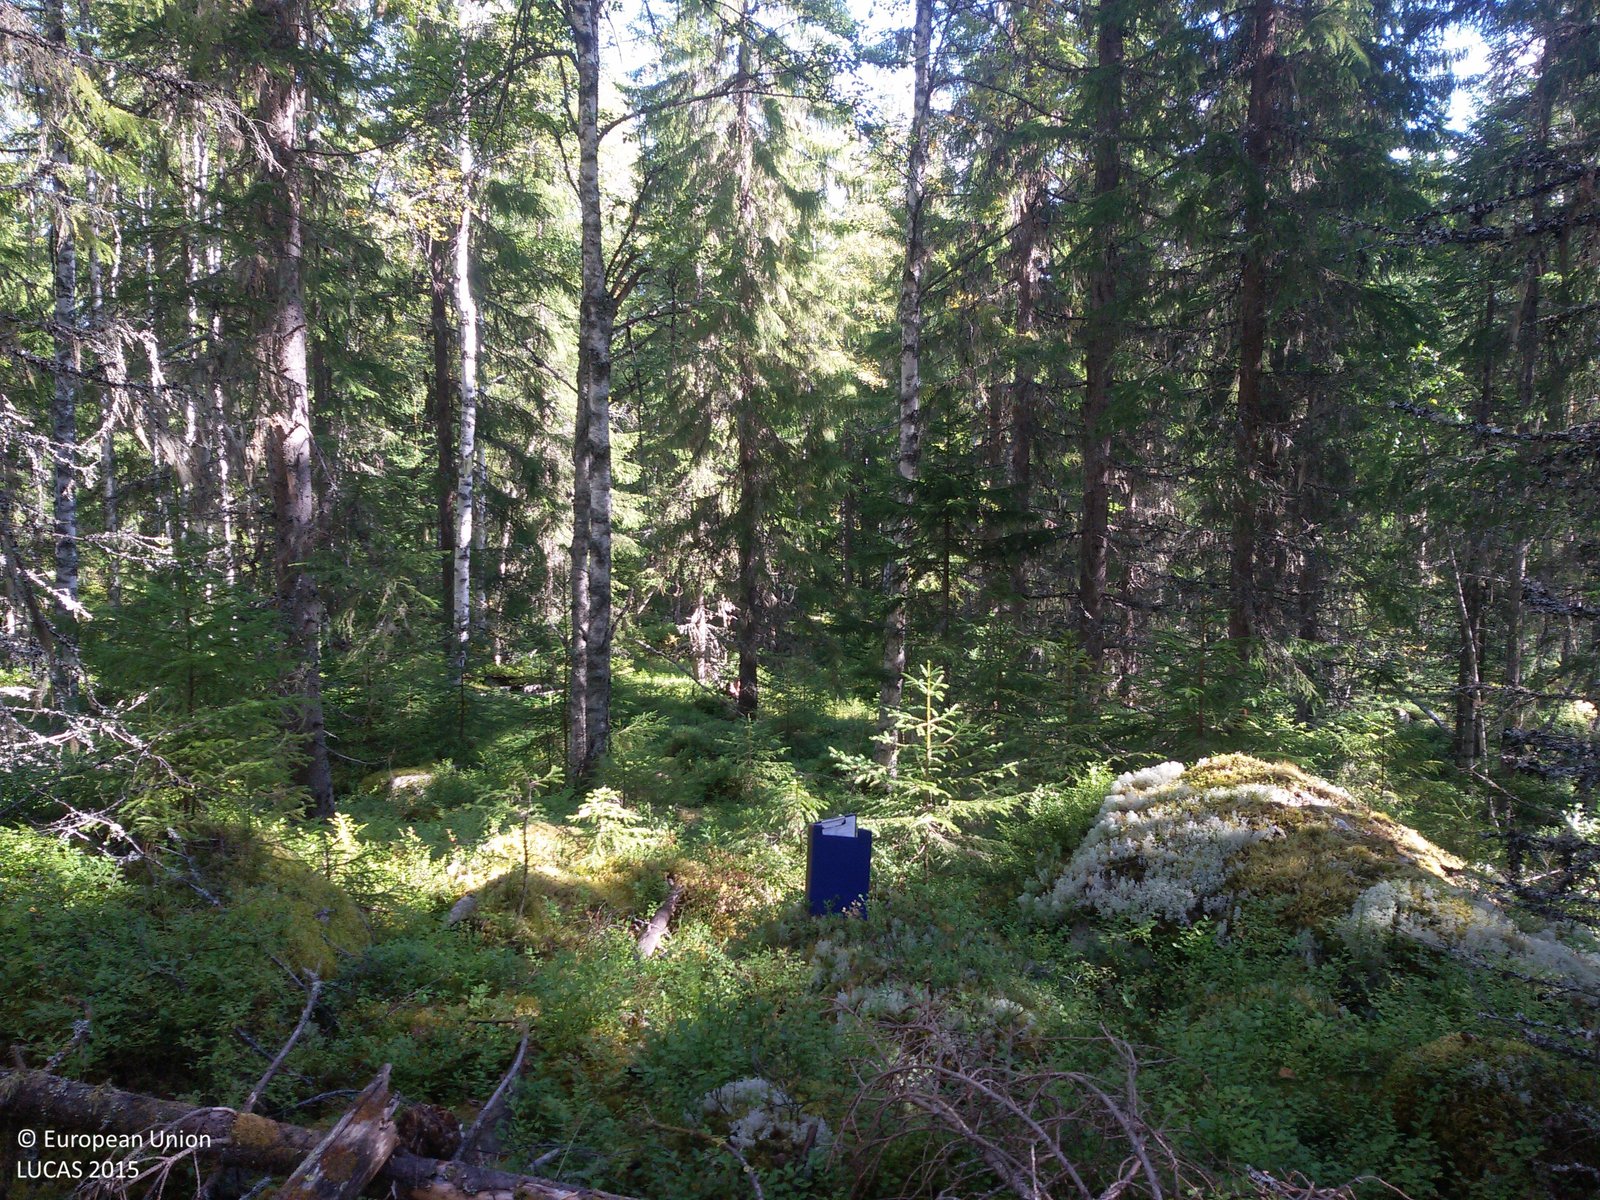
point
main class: Woodland
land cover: Spruce dominated mixed woodland
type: boreal forest
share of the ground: 50 - 75 %
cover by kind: coniferous forest trees 40 %, broadleaved forest trees 30 %, herbaceous plants 30 %
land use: Forestry
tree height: > 5 m
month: September
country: SE
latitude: 60.8763
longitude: 15.2727
